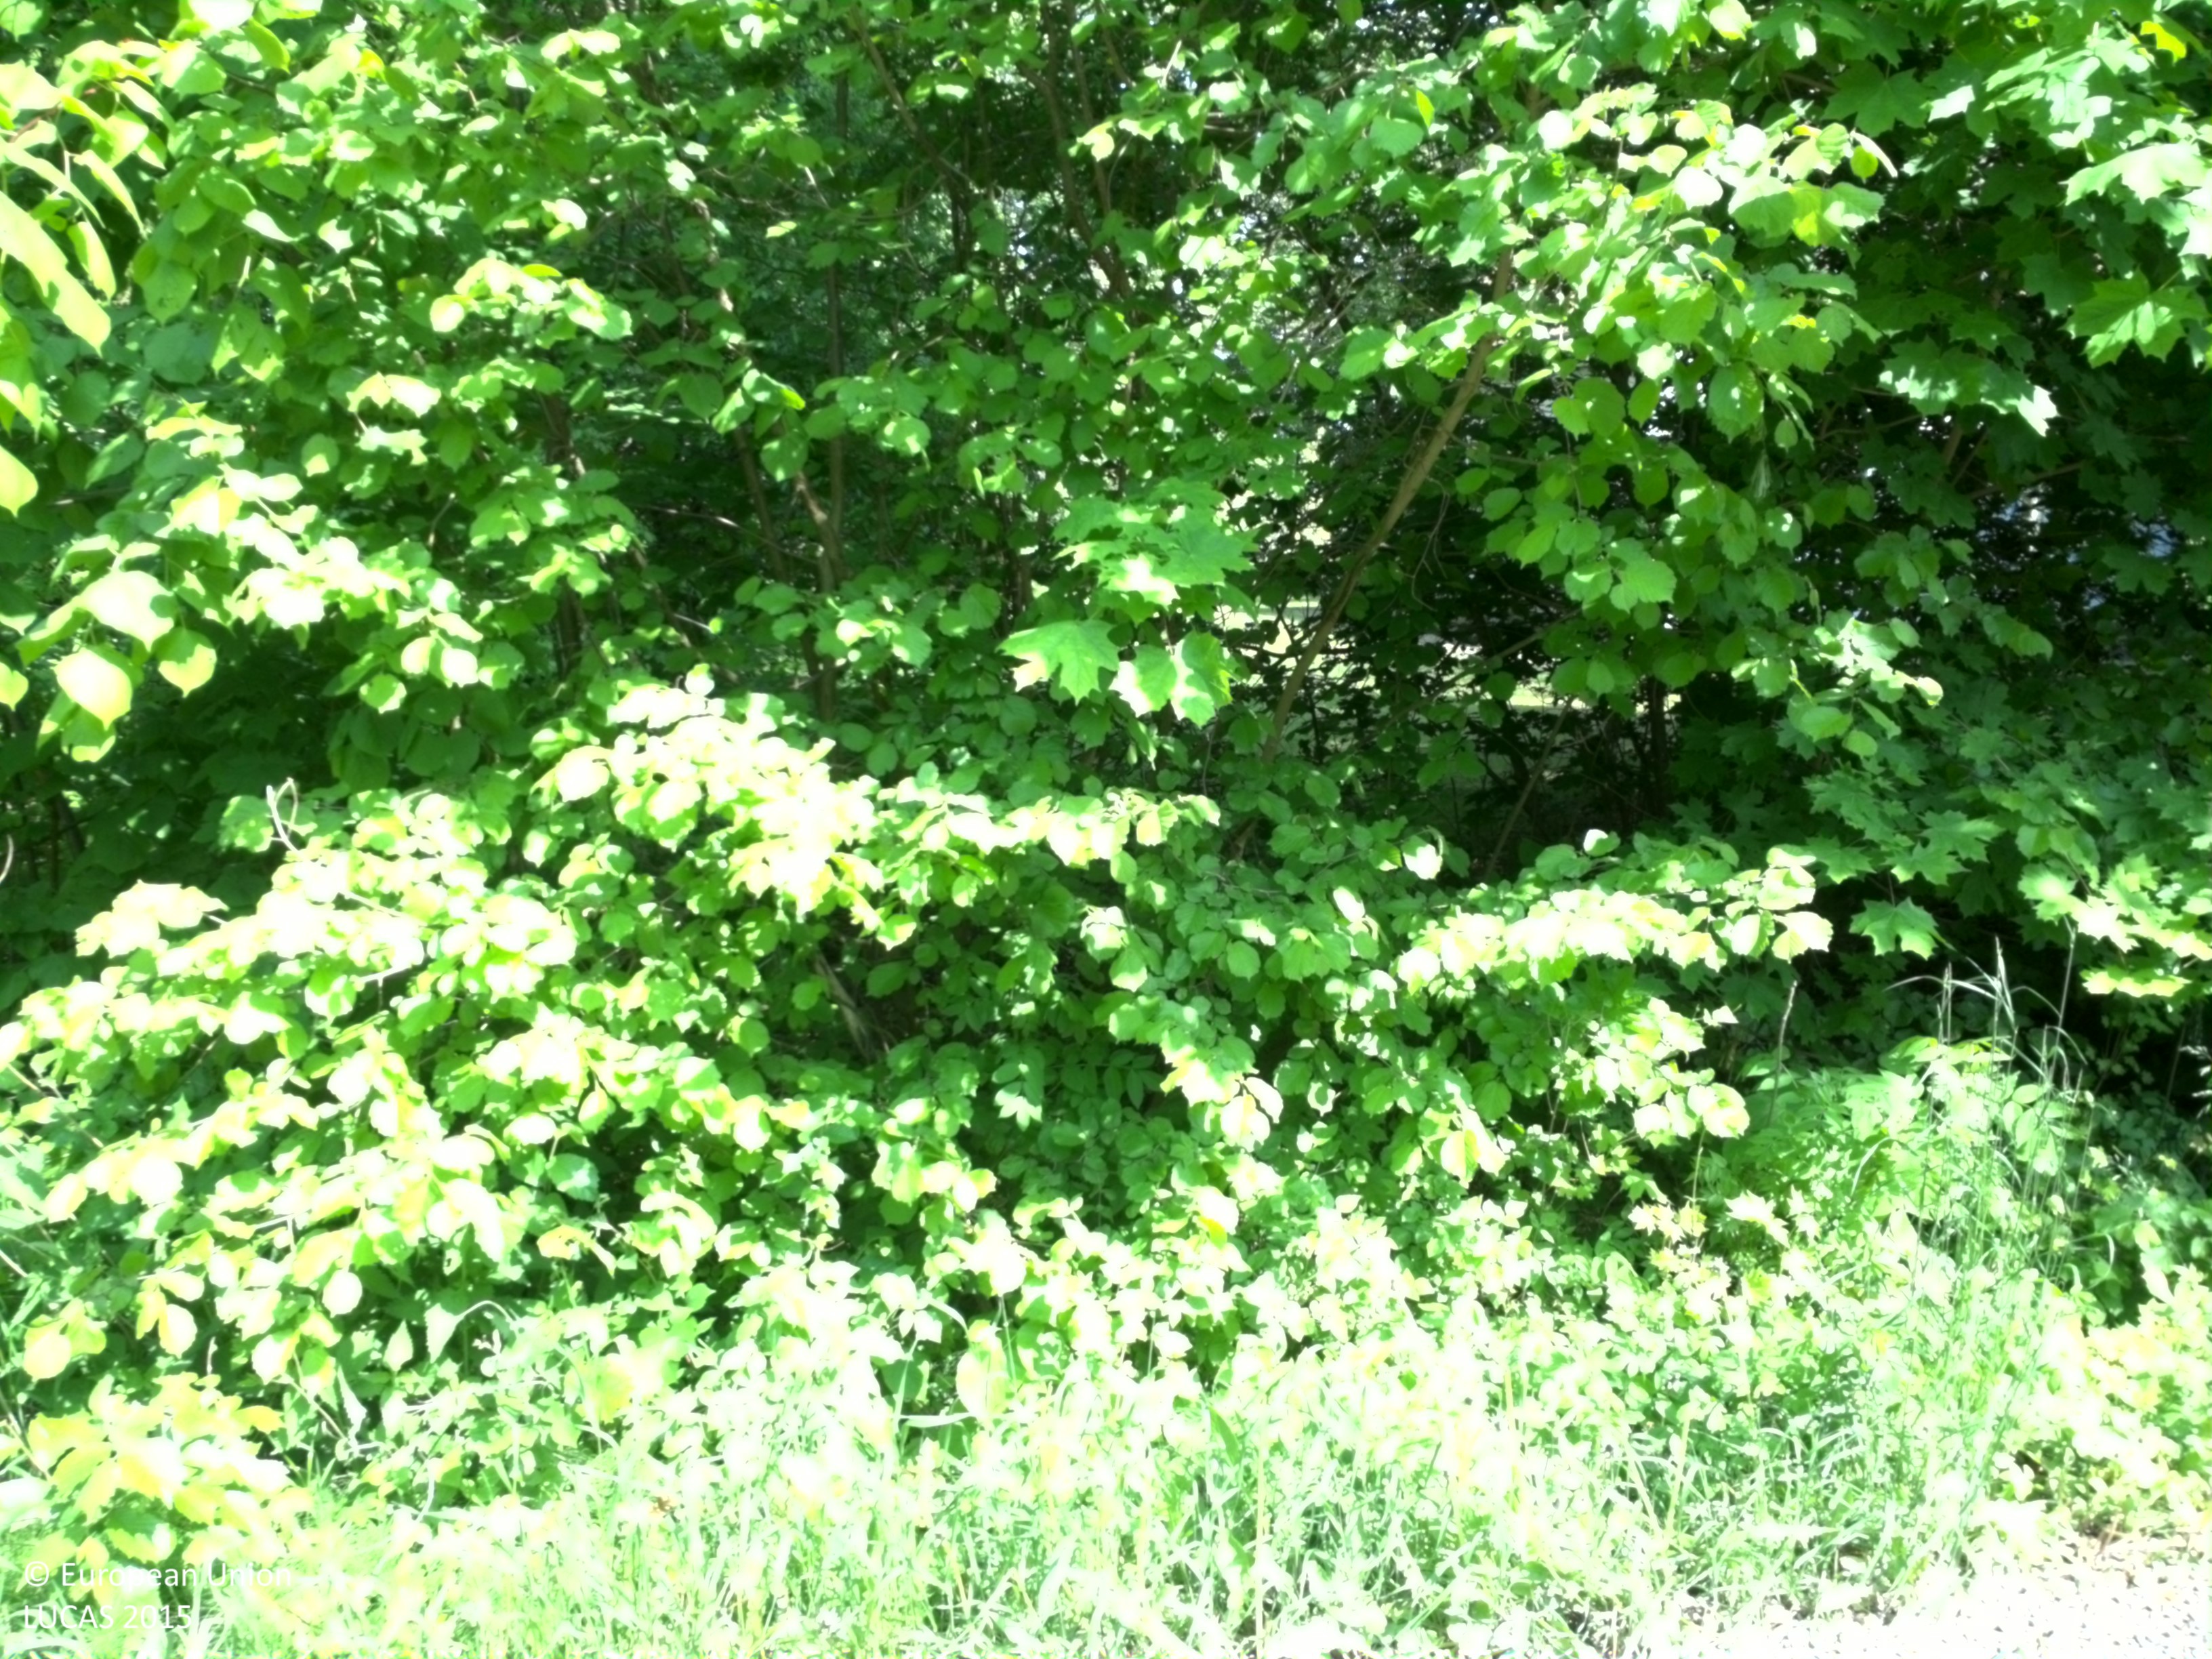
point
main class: Woodland
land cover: Broadleaved woodland
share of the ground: > 75 %
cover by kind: broadleaved forest trees 90 %, herbaceous plants 10 %
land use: Residential
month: June
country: SE
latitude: 58.4871
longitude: 15.4659
